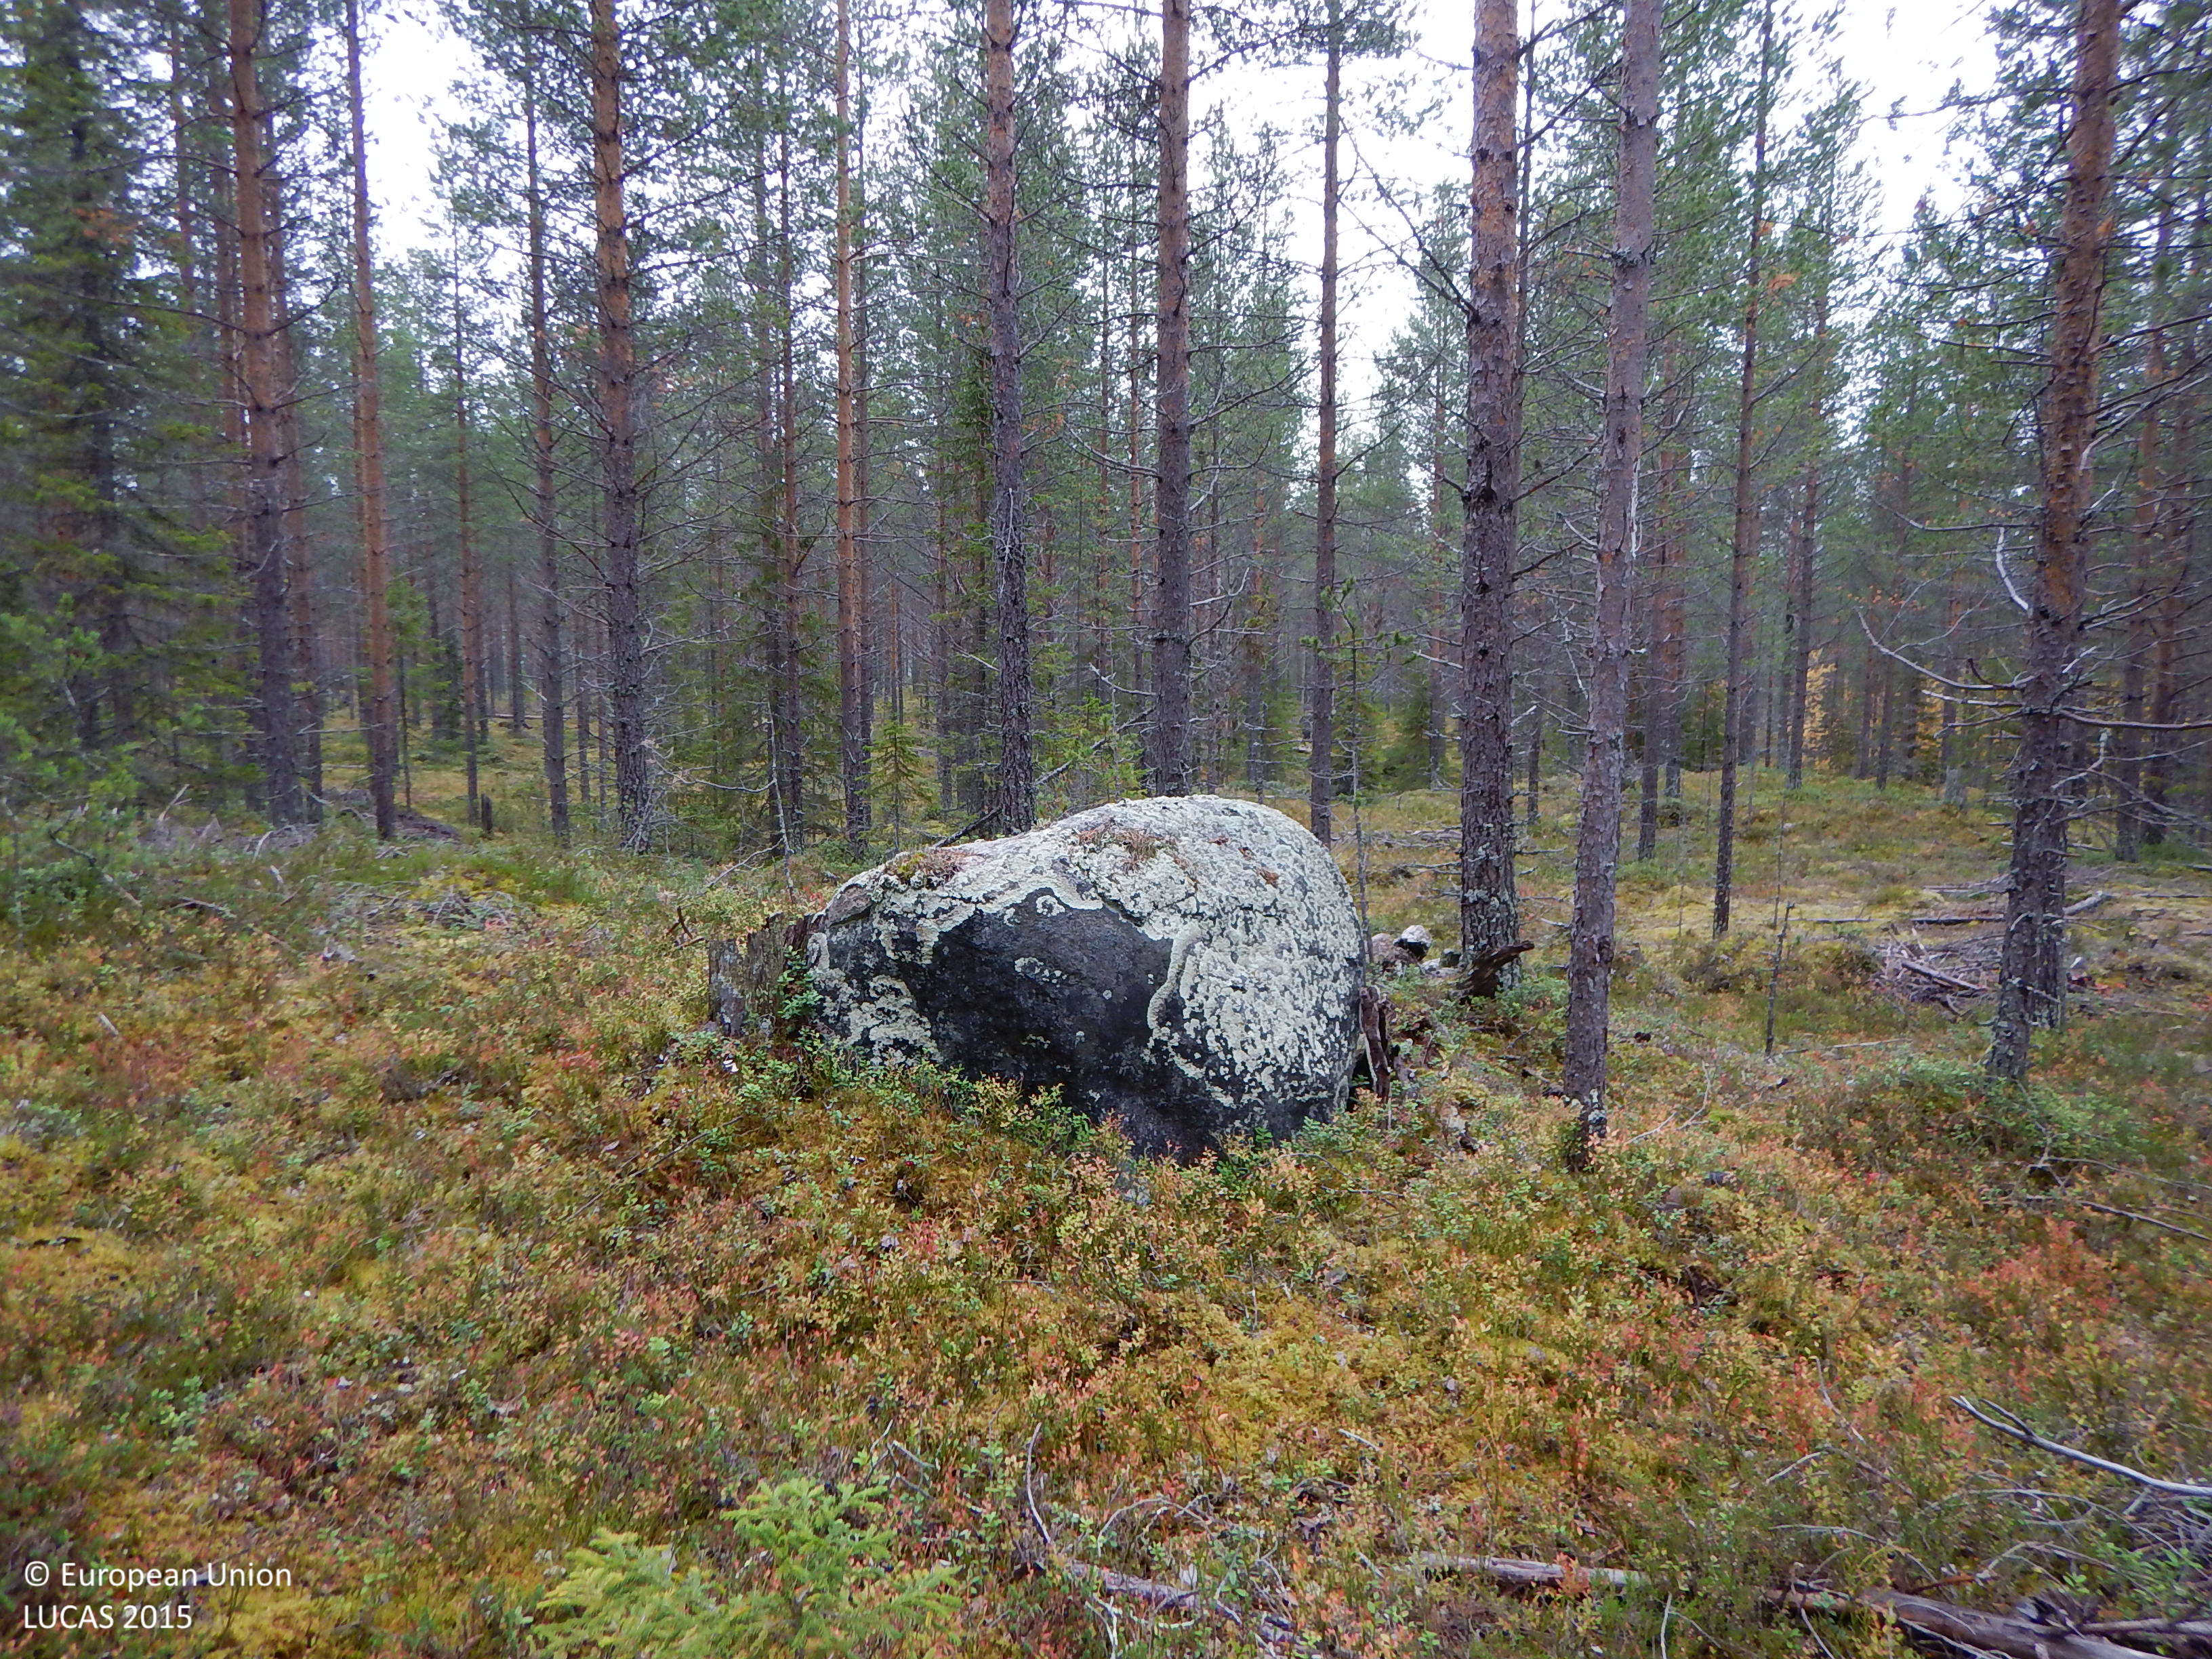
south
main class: Woodland
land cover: Pine dominated coniferous woodland
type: boreal forest
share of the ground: 50 - 75 %
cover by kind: coniferous forest trees 65 %, shrubs 15 %, lichens and mosses 15 %, herbaceous plants 5 %
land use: Forestry
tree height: > 5 m
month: September
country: SE
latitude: 65.0743
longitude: 19.2586
